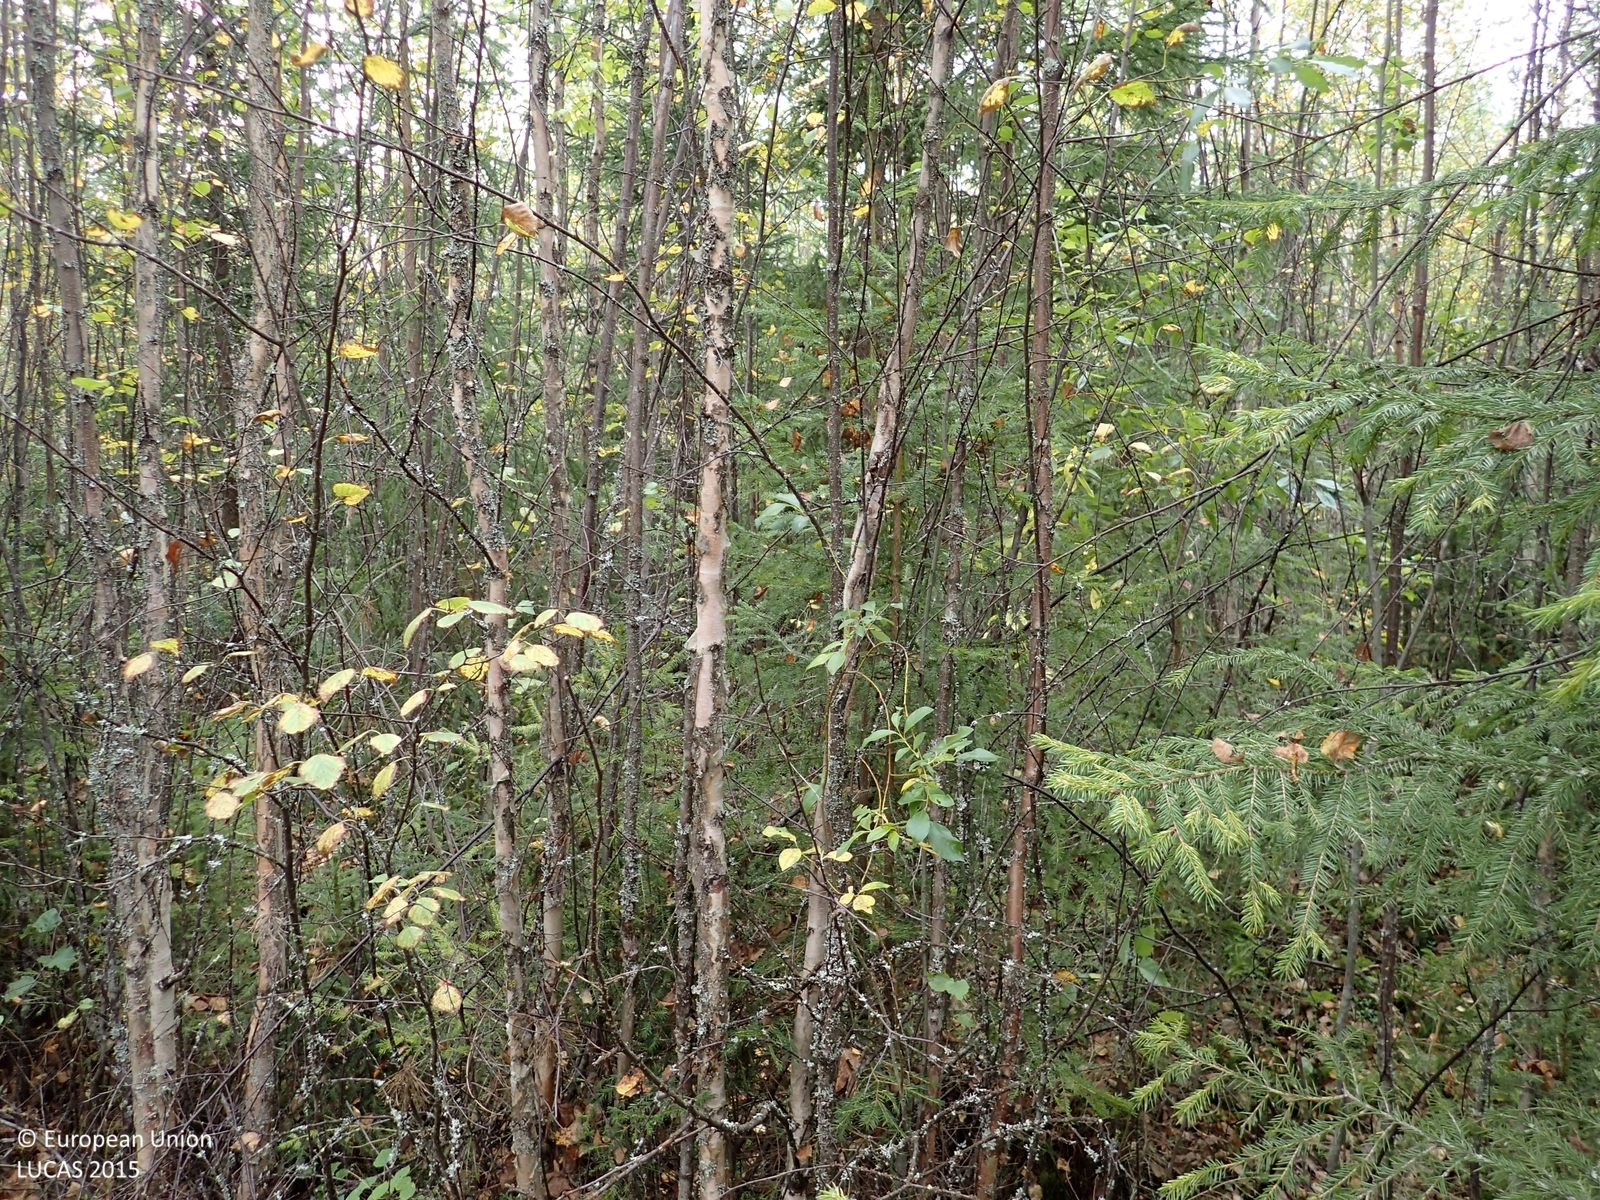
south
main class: Woodland
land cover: Spruce dominated mixed woodland
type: boreal forest
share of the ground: > 75 %
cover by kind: broadleaved forest trees 50 %, coniferous forest trees 35 %, shrubs 5 %, herbaceous plants 5 %, lichens and mosses 5 %
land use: Forestry
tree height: < 5 m
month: September
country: FI
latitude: 62.9199
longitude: 25.9289
